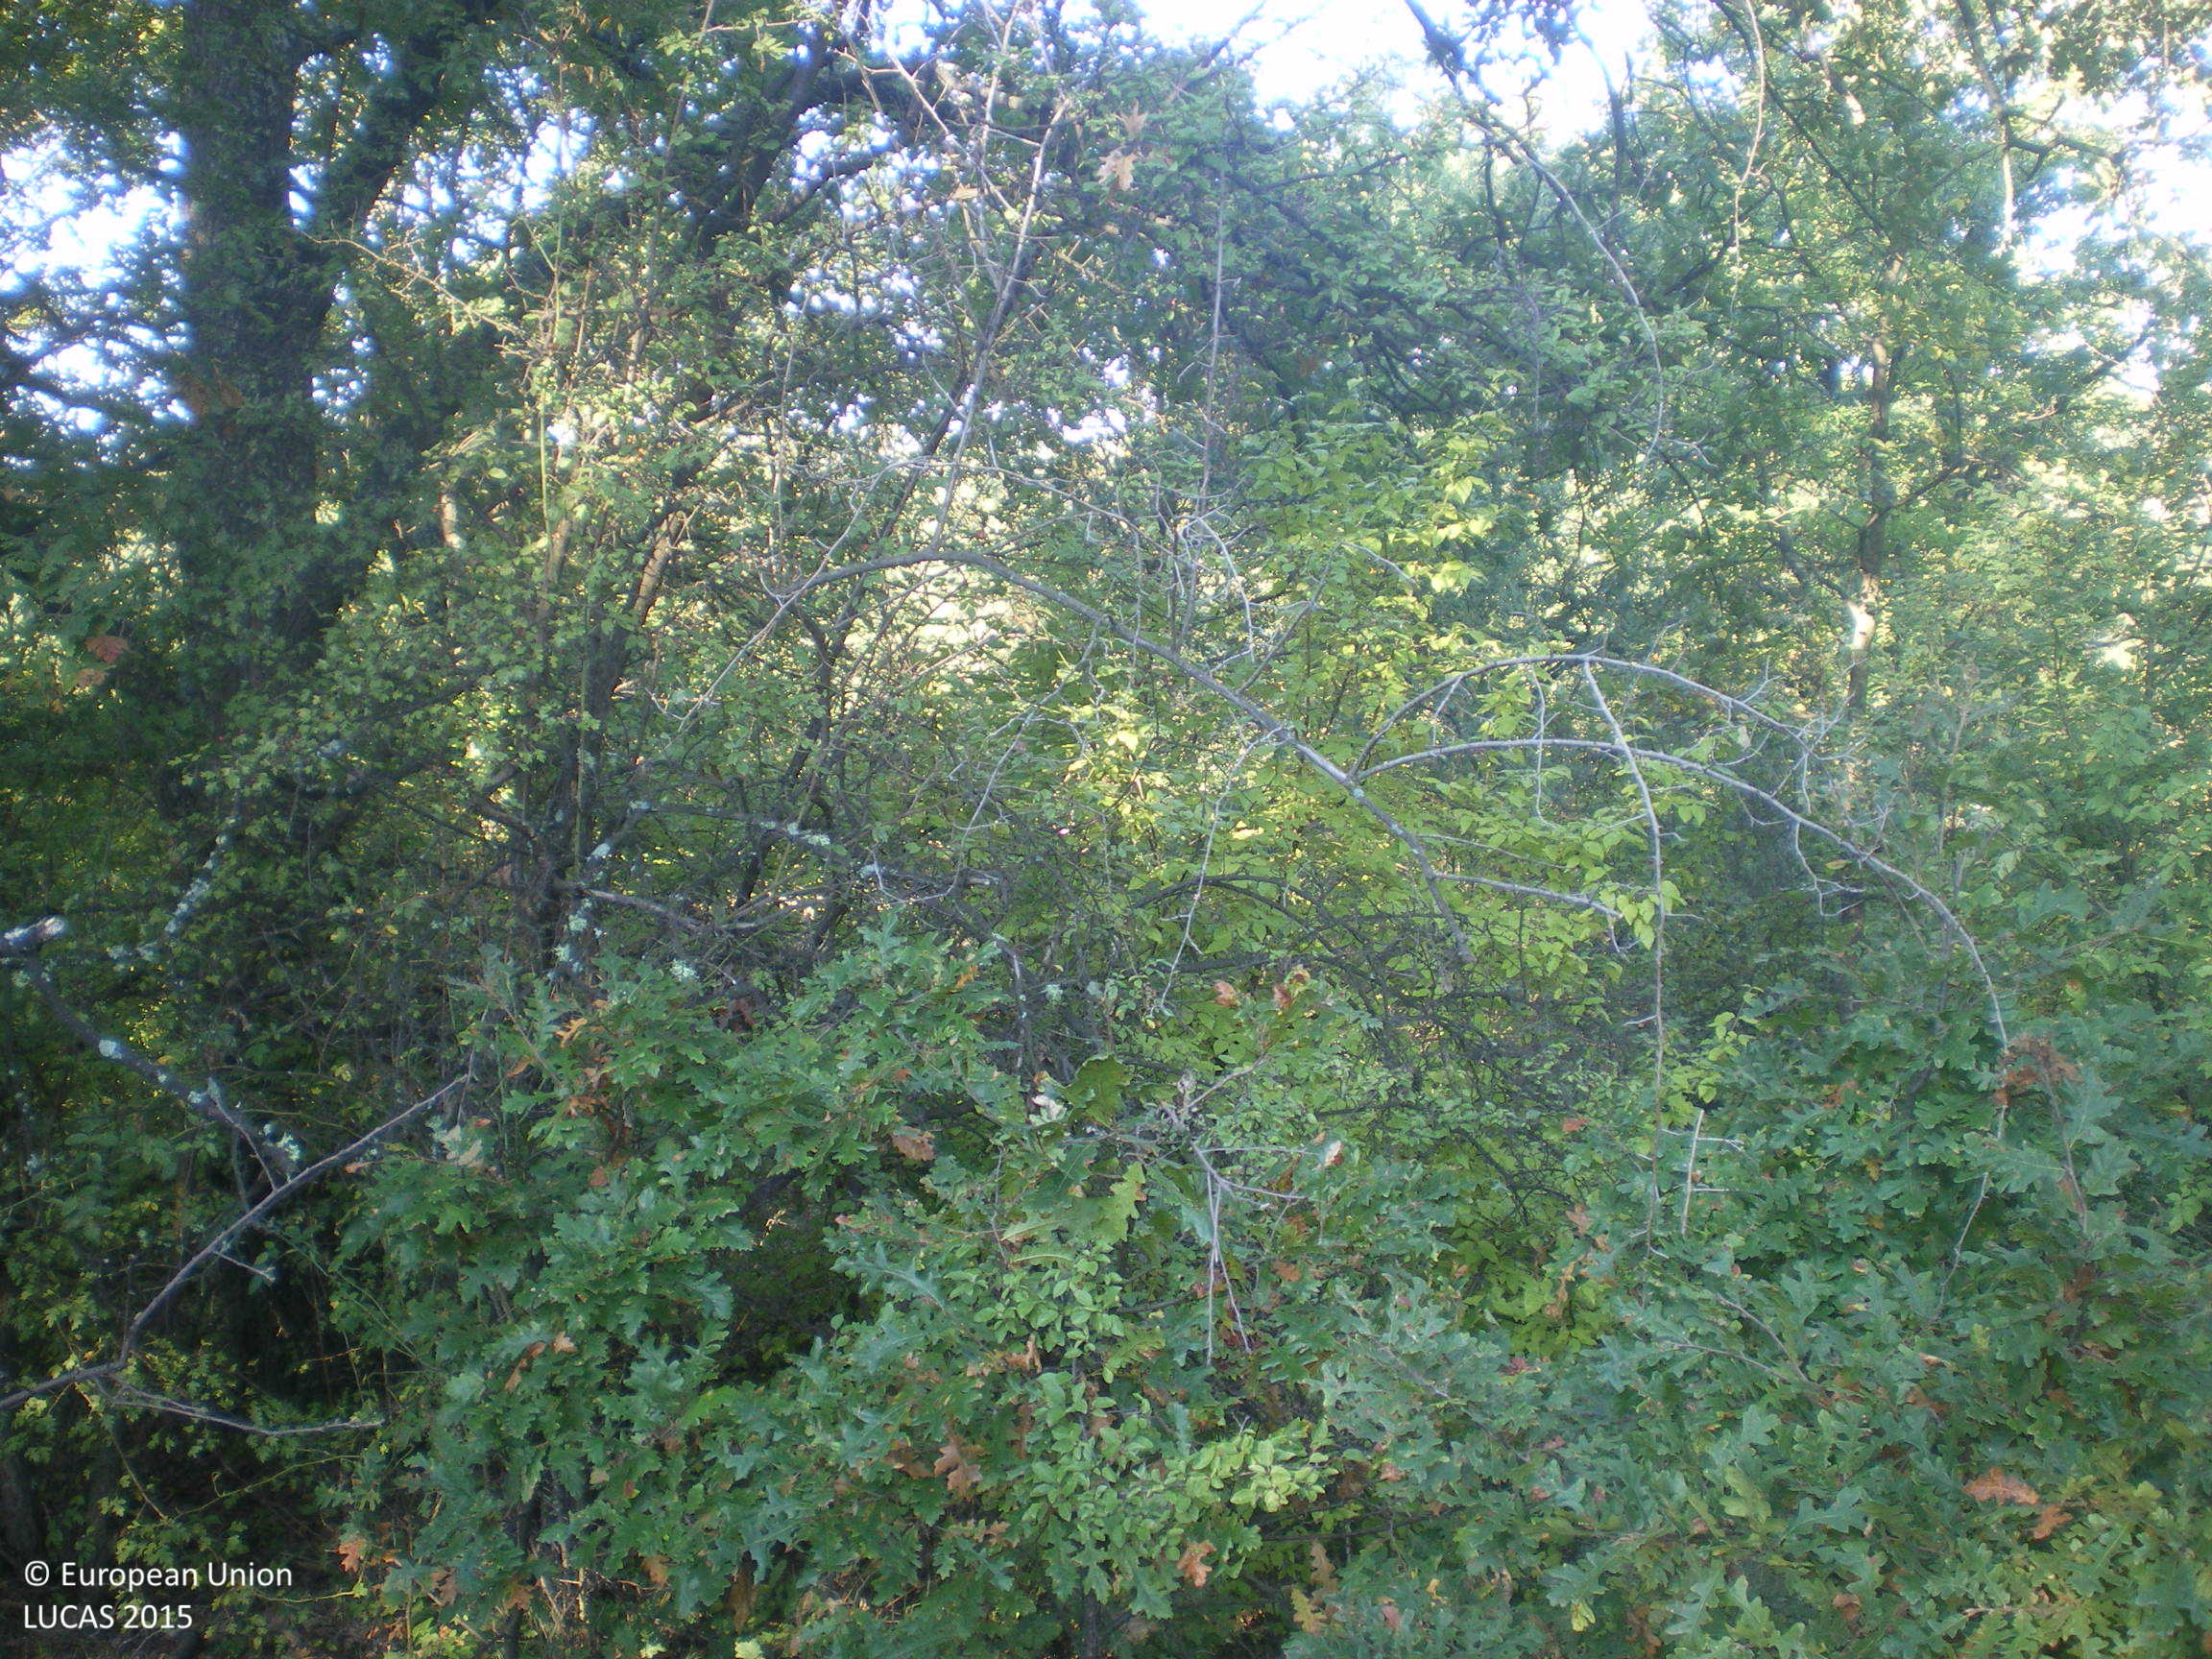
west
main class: Woodland
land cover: Broadleaved woodland
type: mesophytic deciduous forest
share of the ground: > 75 %
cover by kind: broadleaved forest trees 100 %
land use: Forestry
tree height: > 5 m
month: October
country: BG
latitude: 42.0335
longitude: 26.2297
